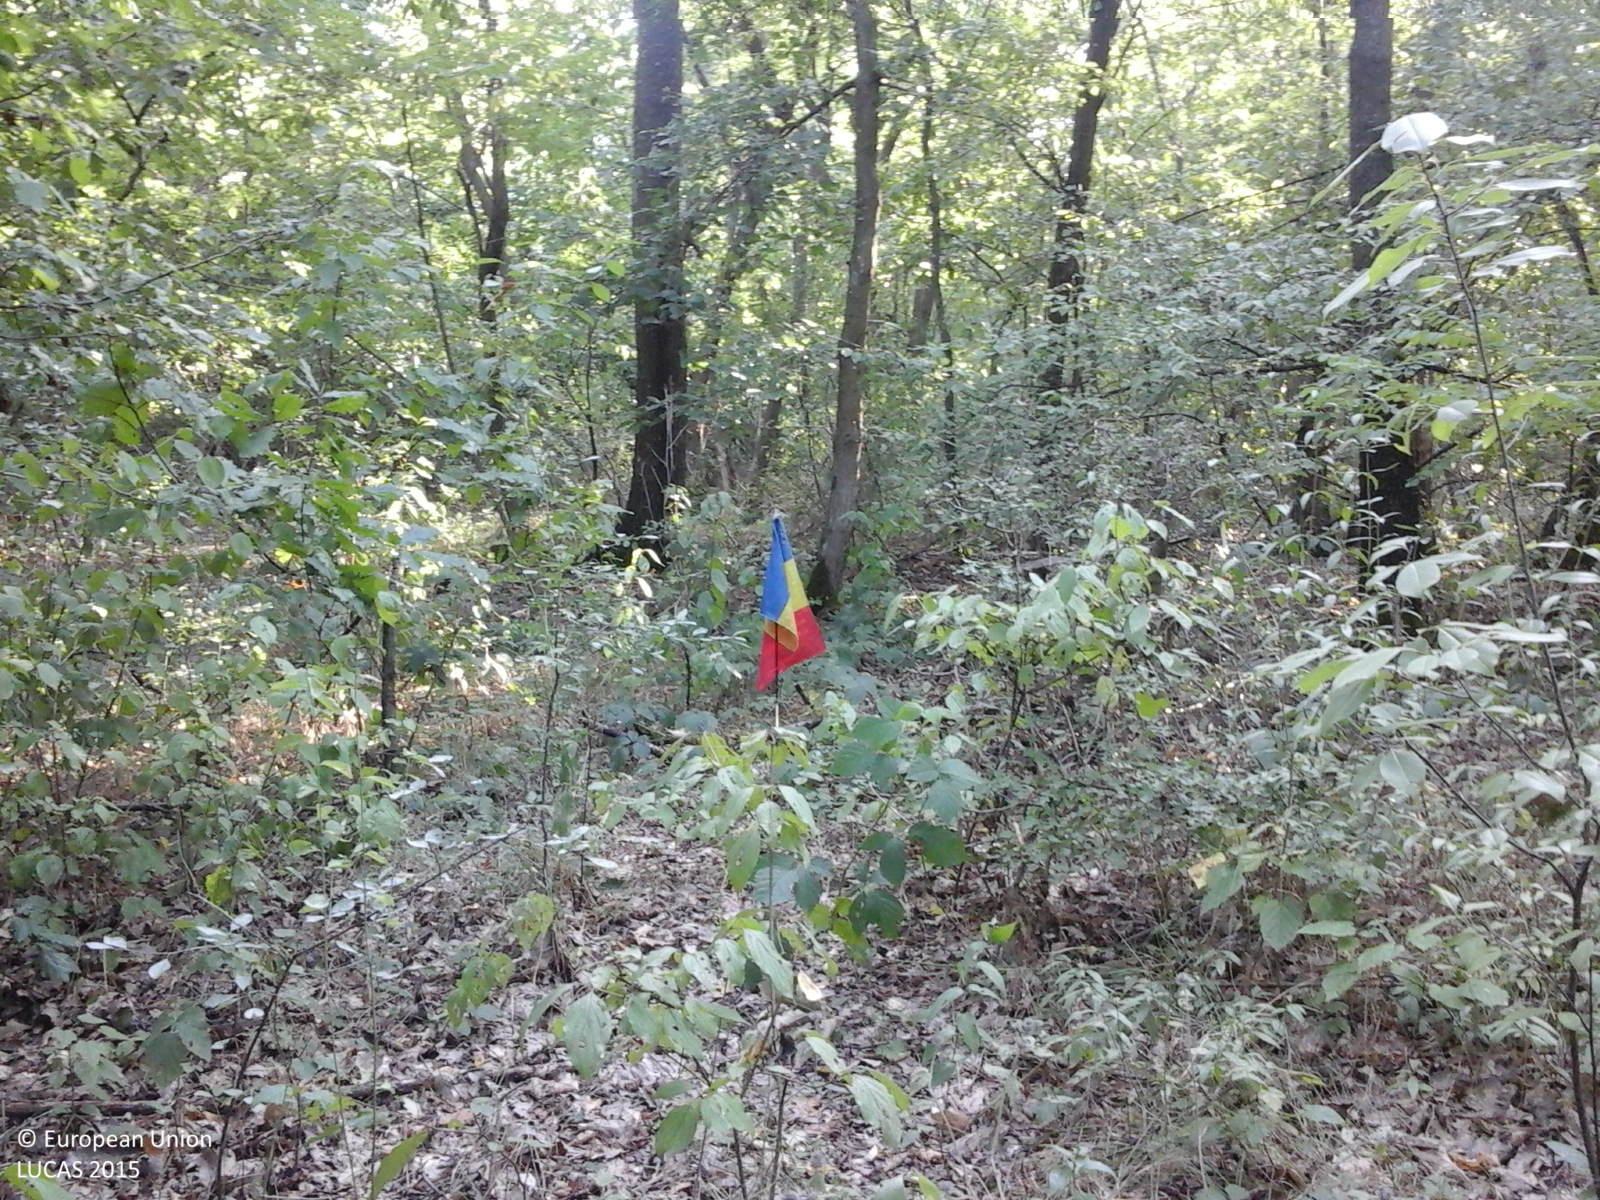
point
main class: Woodland
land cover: Broadleaved woodland
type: acidophilous oak and oak-birch forest
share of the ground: > 75 %
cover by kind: broadleaved forest trees 100 %
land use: Forestry
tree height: > 5 m
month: September
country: RO
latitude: 47.2483
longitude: 22.7030
